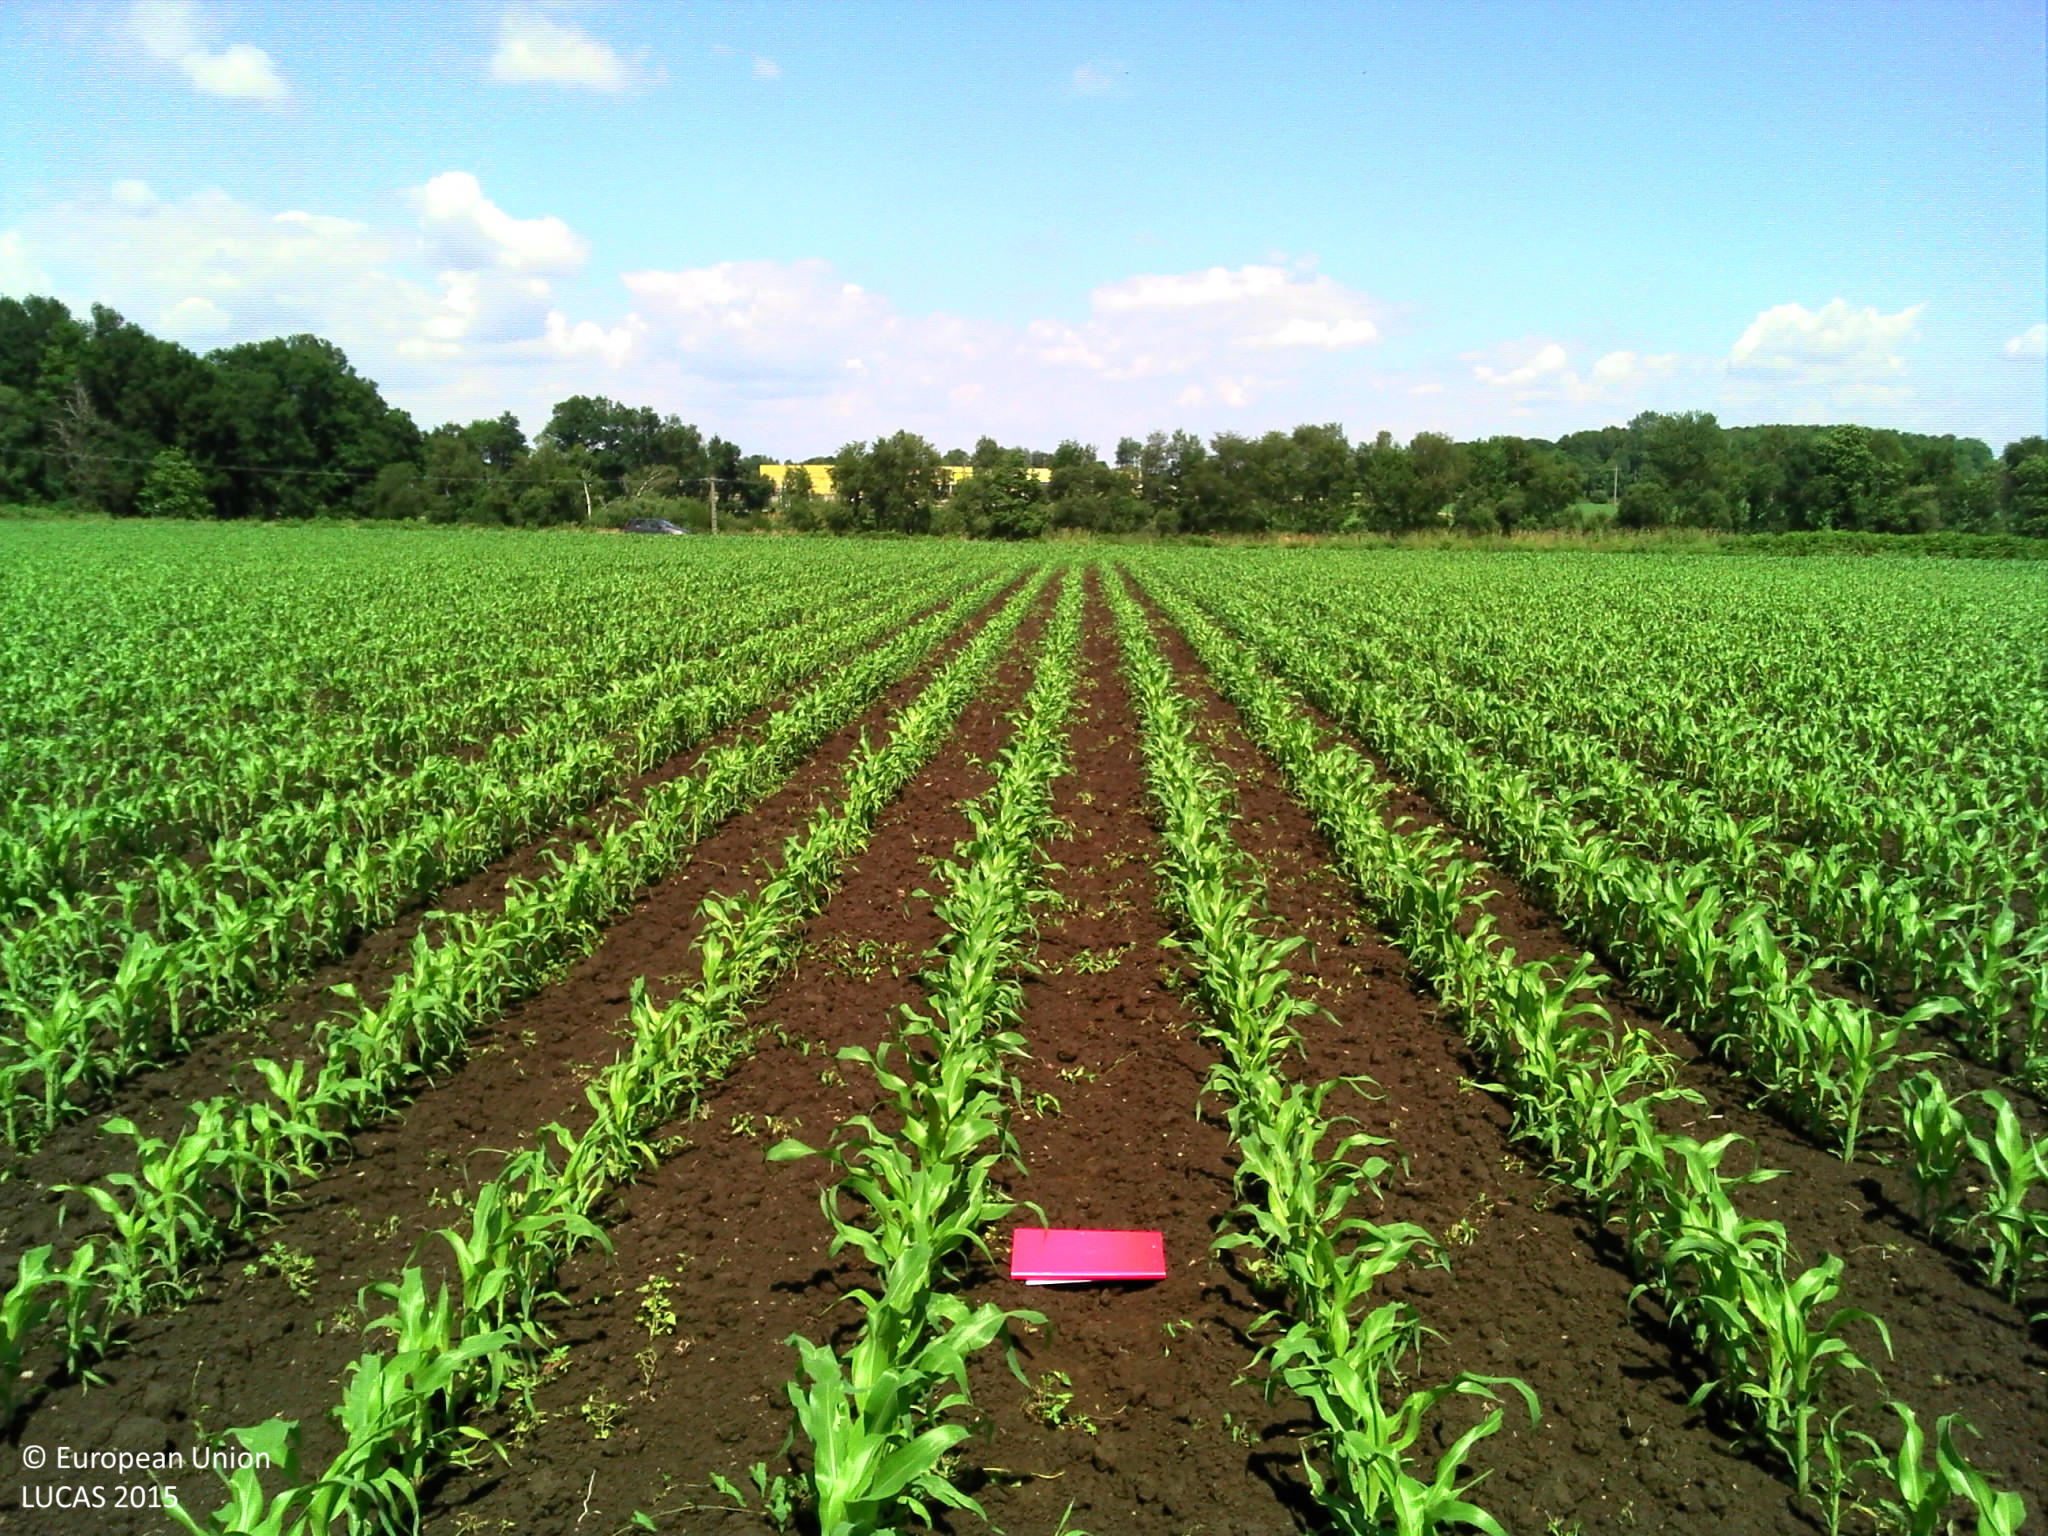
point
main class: Cropland
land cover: Maize
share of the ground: 25 - 50 %
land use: Agriculture (excluding fallow land and kitchen gardens)
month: June
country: FR
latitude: 43.2528
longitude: -0.1419
